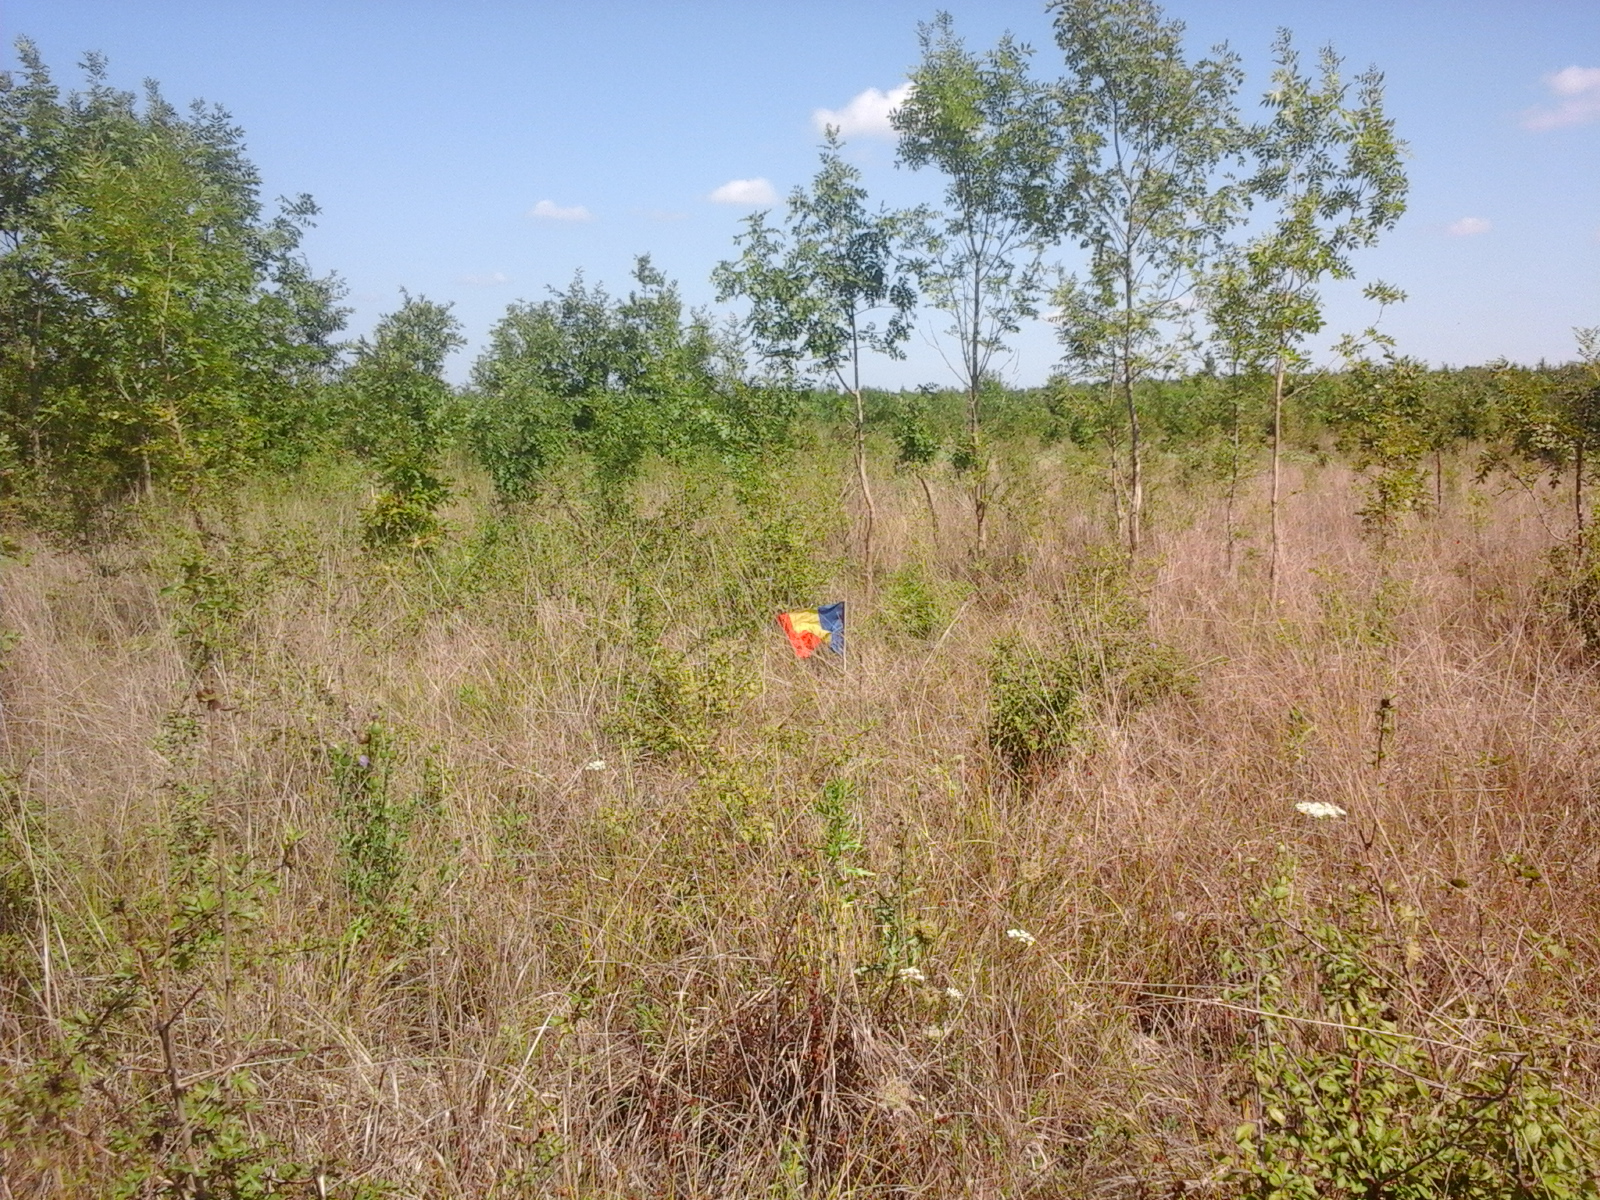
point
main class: Grassland
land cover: Grassland with sparse tree/shrub cover
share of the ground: > 75 %
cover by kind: herbaceous plants 95 %, broadleaved forest trees 5 %
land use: Fallow land
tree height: > 5 m
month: August
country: RO
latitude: 46.1201
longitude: 21.0689
